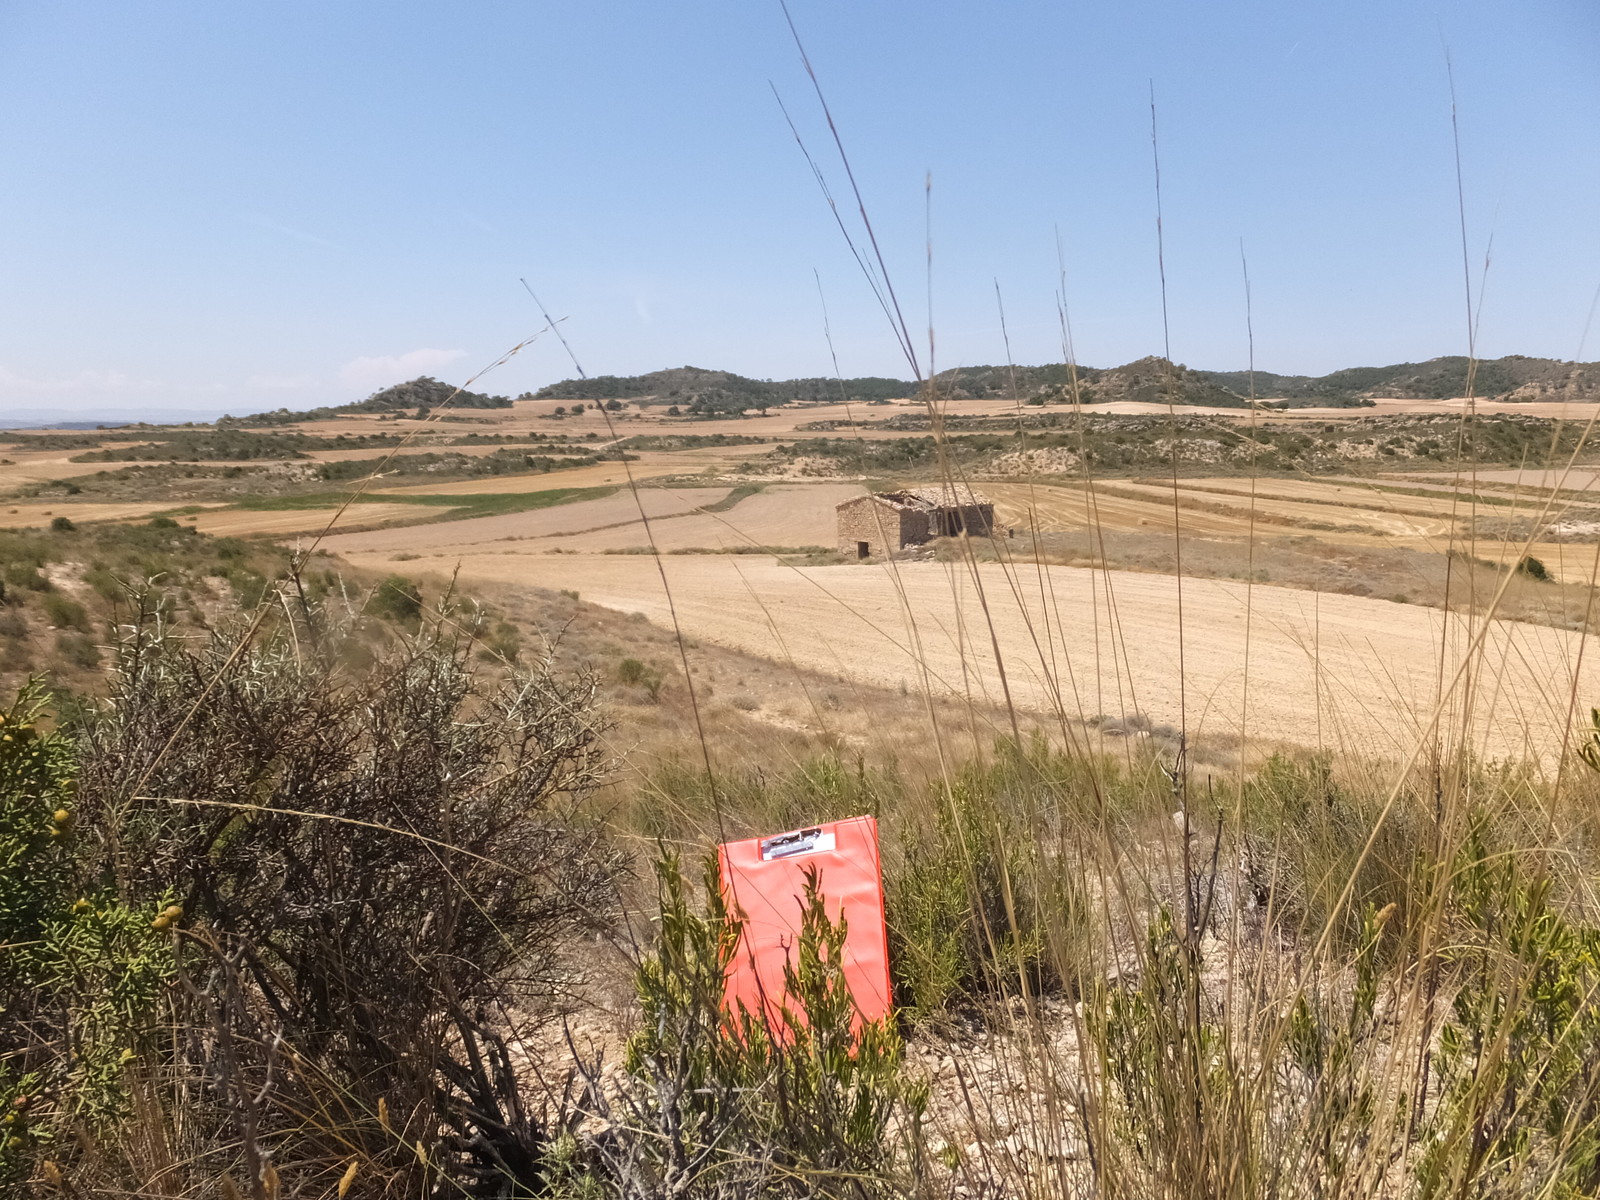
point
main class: Shrubland
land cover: Shrubland without tree cover
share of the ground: > 75 %
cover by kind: shrubs 40 %, herbaceous plants 40 %, consolidated bare surface 20 %
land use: Semi-natural and natural areas not in use
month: June
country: ES
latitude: 41.3258
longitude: -0.1334
